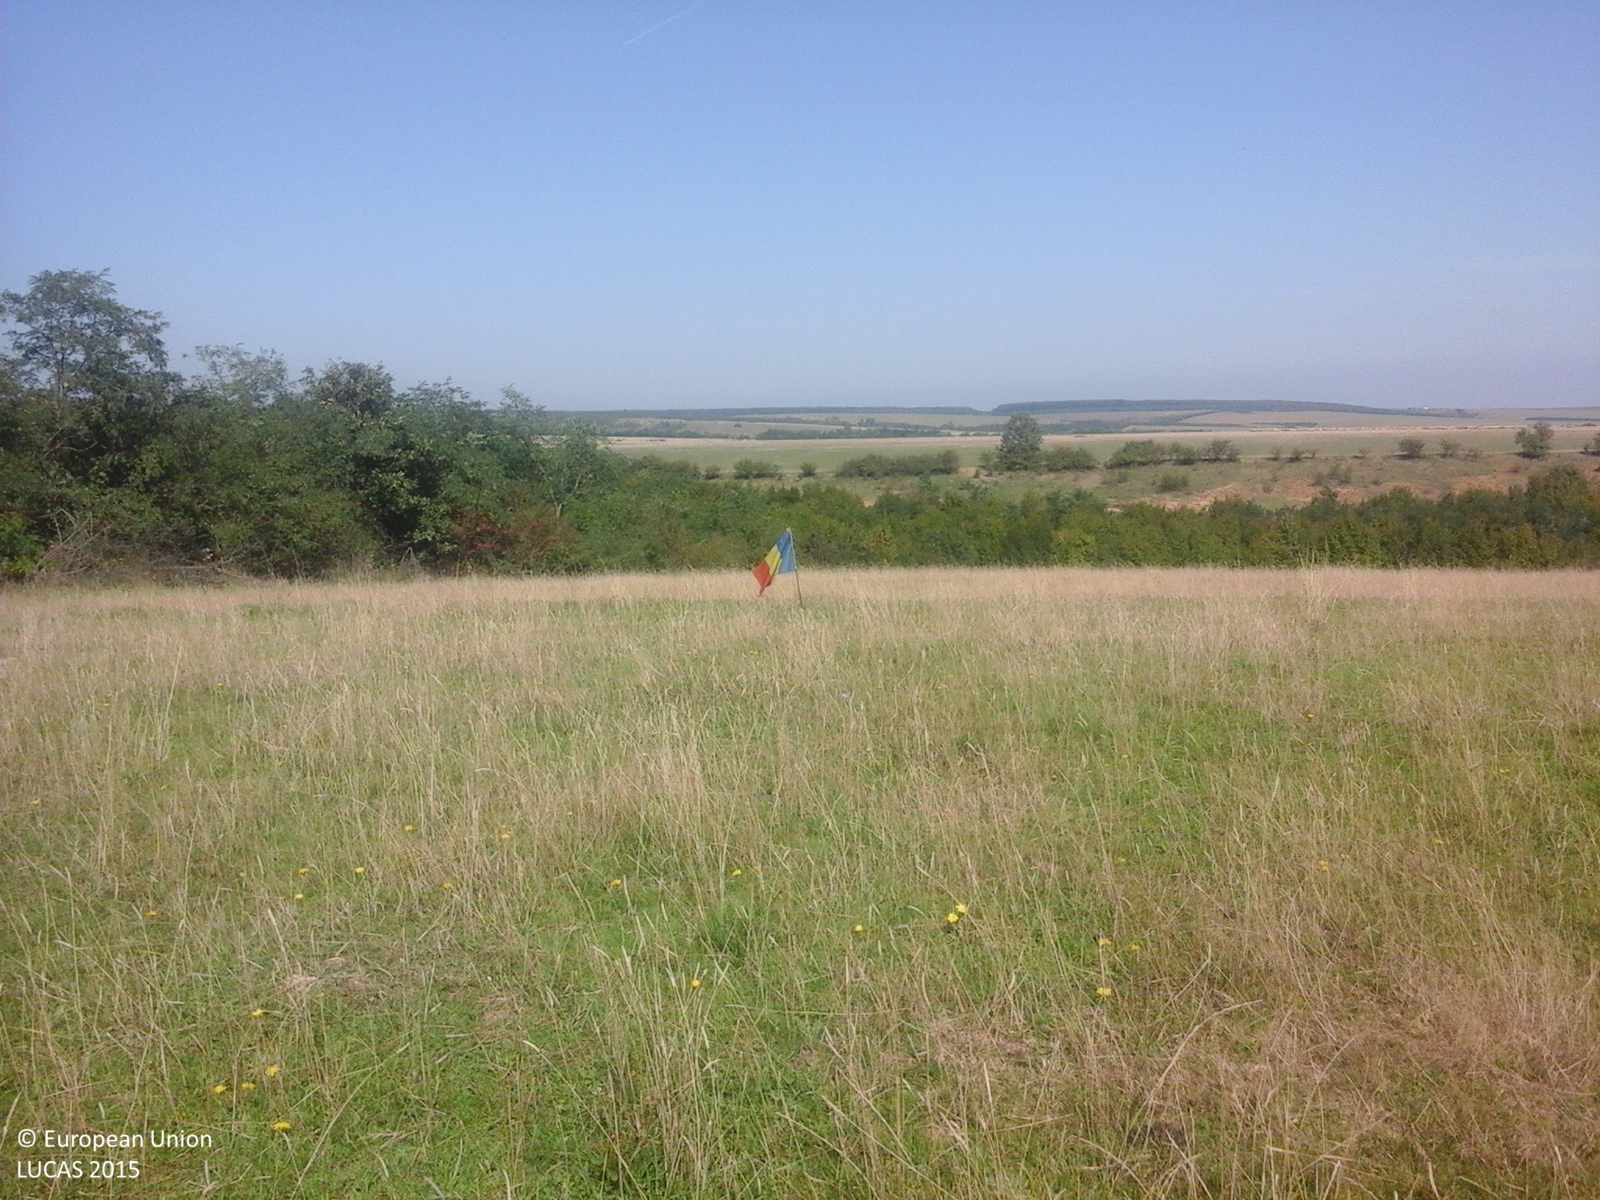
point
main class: Grassland
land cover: Grassland without tree/shrub cover
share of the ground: > 75 %
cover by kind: herbaceous plants 100 %
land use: Agriculture (excluding fallow land and kitchen gardens)
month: September
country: RO
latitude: 47.4076
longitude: 22.7425
